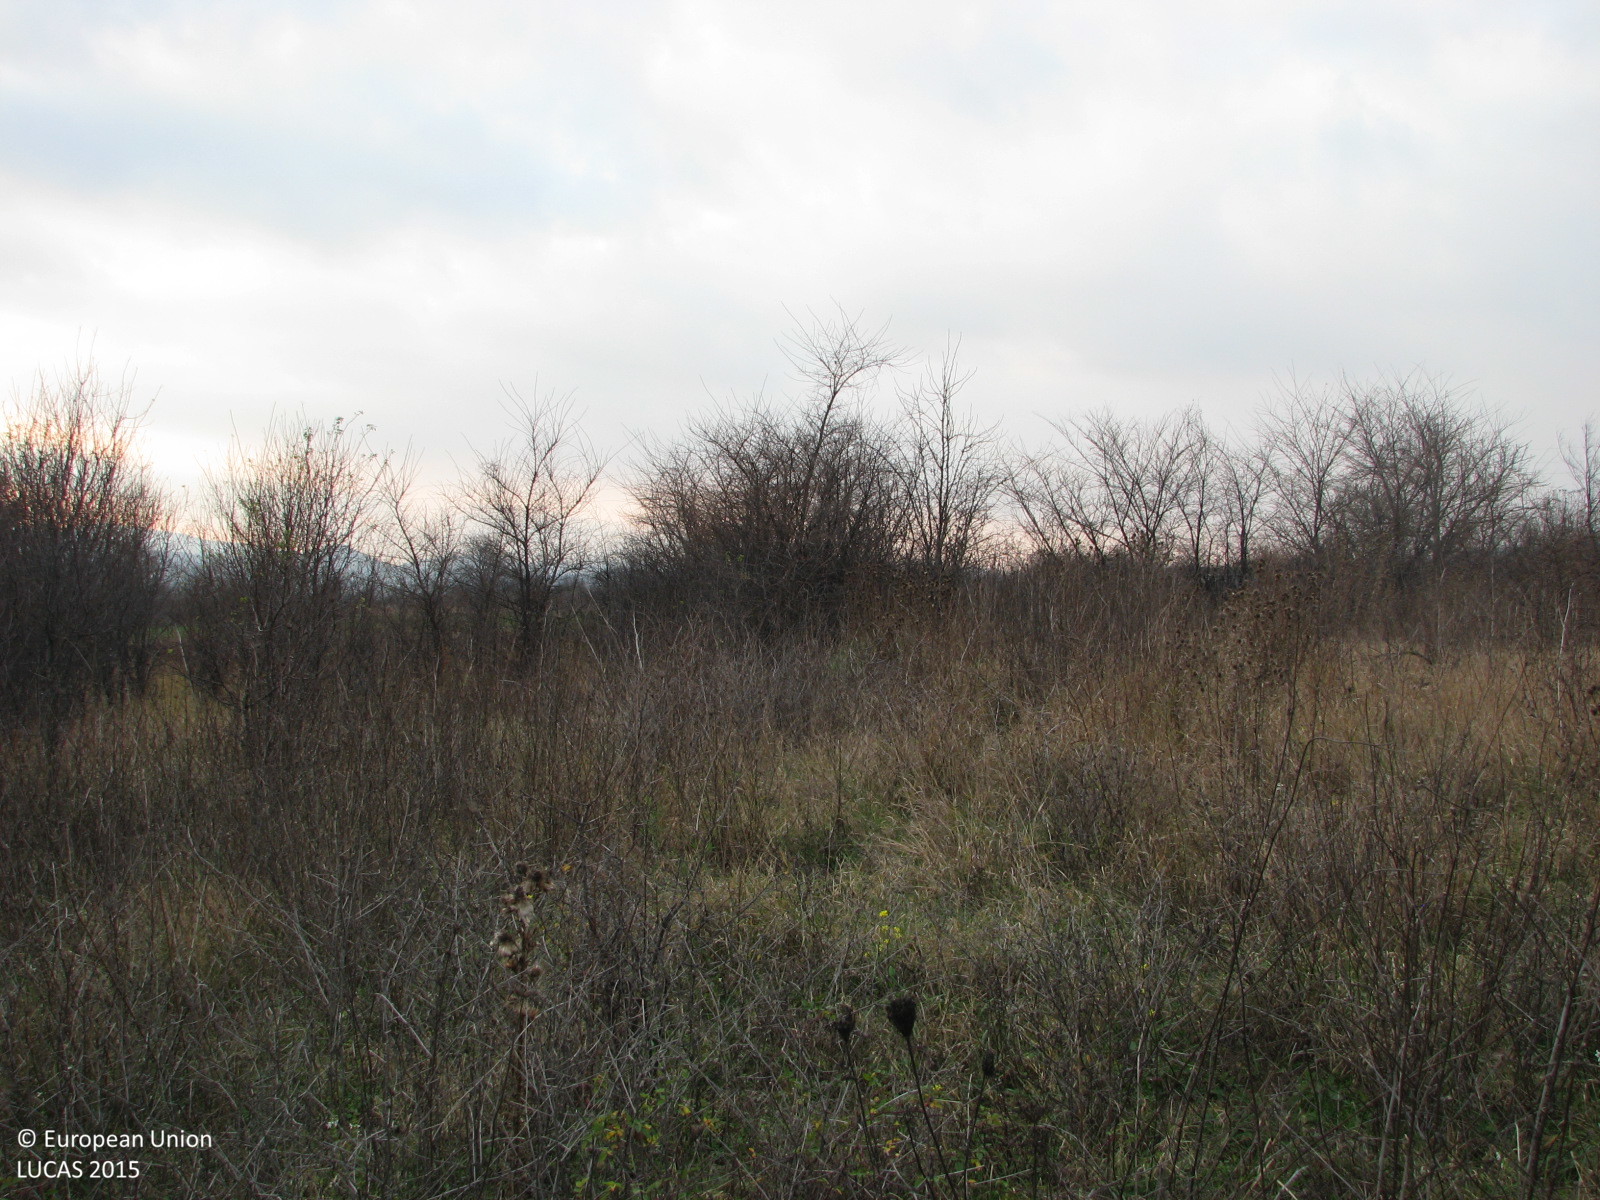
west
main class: Shrubland
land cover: Shrubland with sparse tree cover
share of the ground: 25 - 50 %
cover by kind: herbaceous plants 60 %, shrubs 35 %, broadleaved forest trees 5 %
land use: Fallow land
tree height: < 5 m
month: December
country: BG
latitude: 42.4551
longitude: 24.1871
